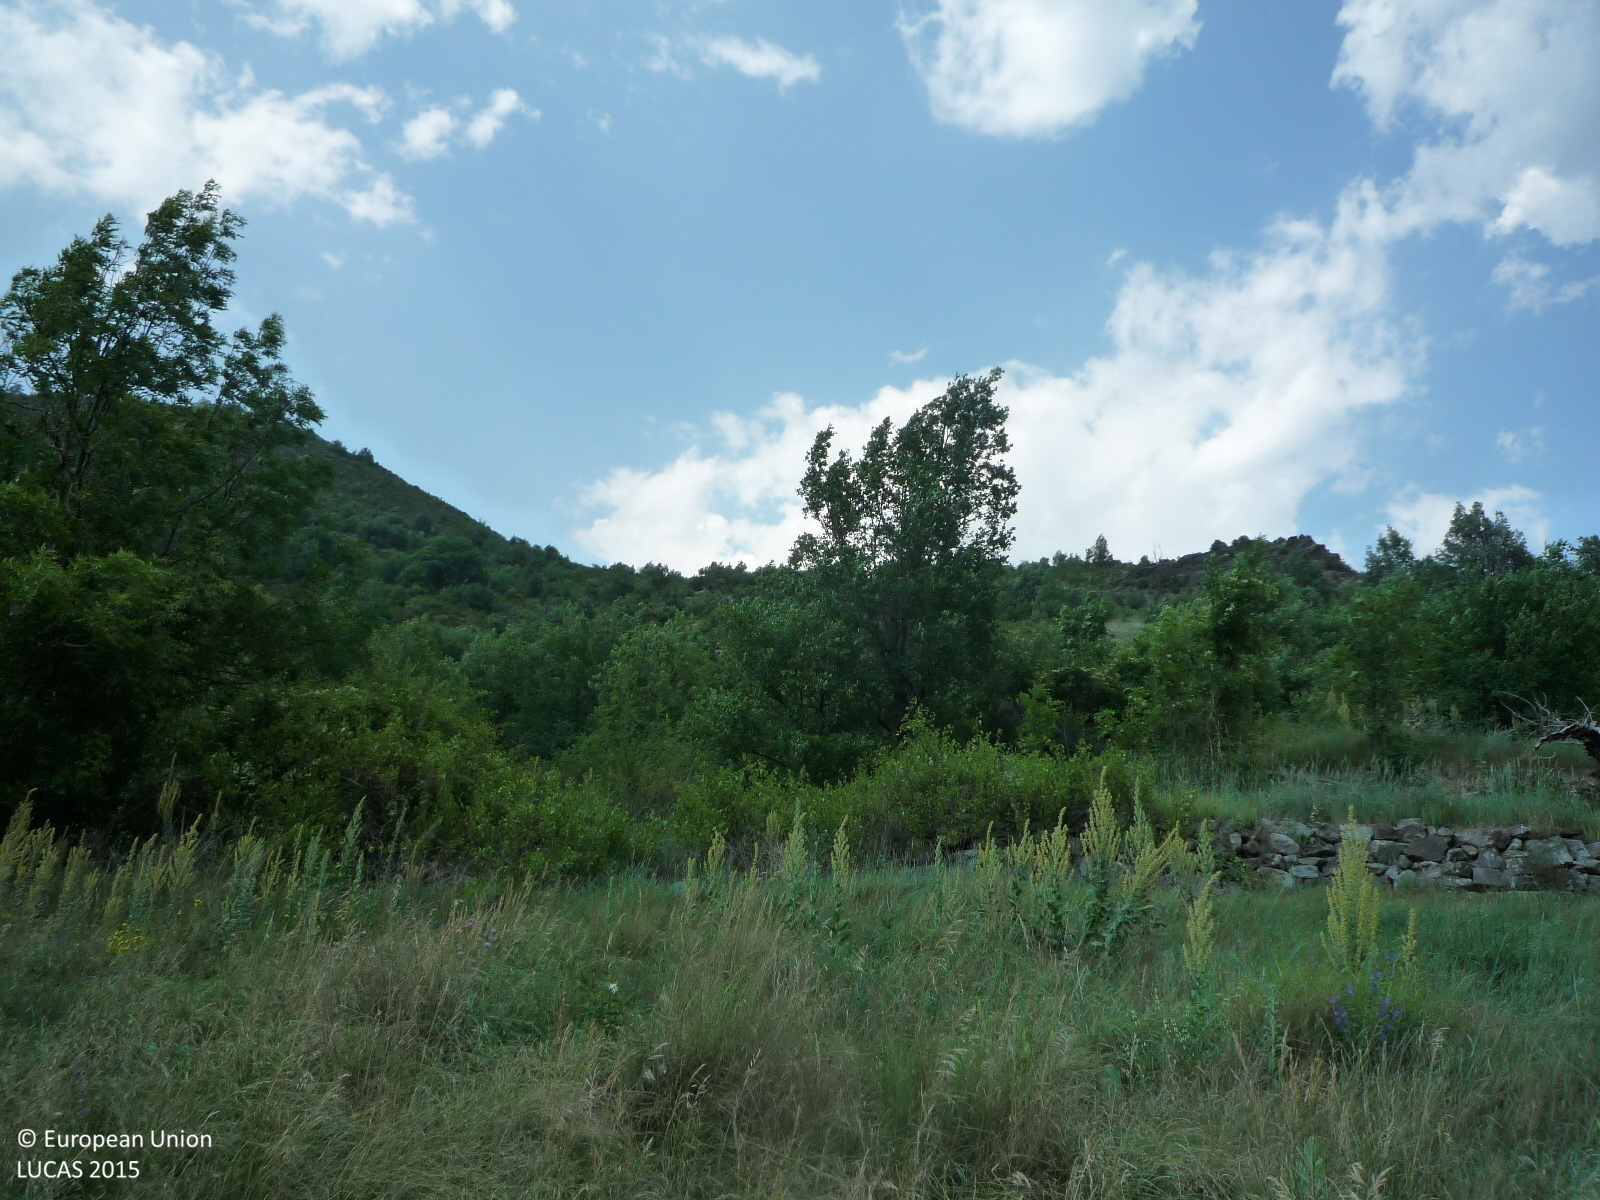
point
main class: Woodland
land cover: Broadleaved woodland
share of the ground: > 75 %
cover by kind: broadleaved forest trees 70 %, shrubs 30 %
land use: Semi-natural and natural areas not in use
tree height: < 5 m
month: June
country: ES
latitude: 42.3648
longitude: 1.6689
